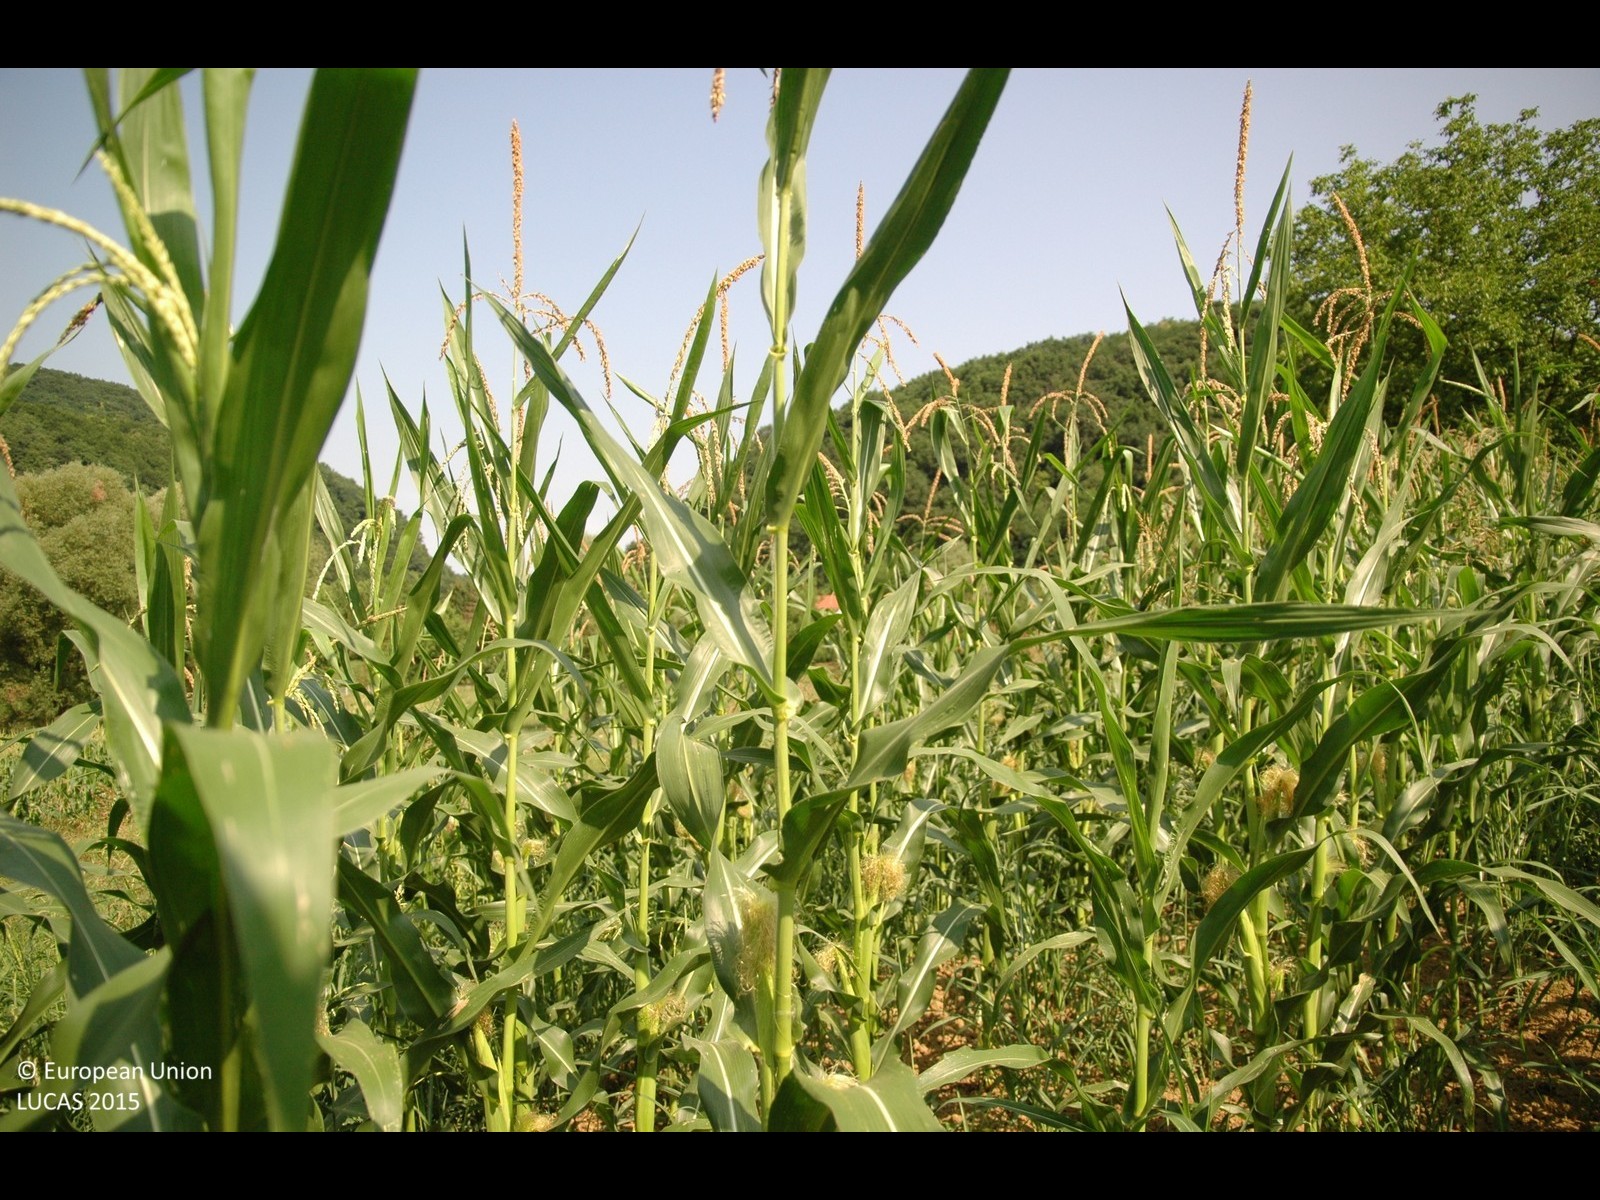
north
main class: Cropland
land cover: Maize
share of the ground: > 75 %
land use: Agriculture (excluding fallow land and kitchen gardens)
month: July
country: HR
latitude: 46.1097
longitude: 16.0149
